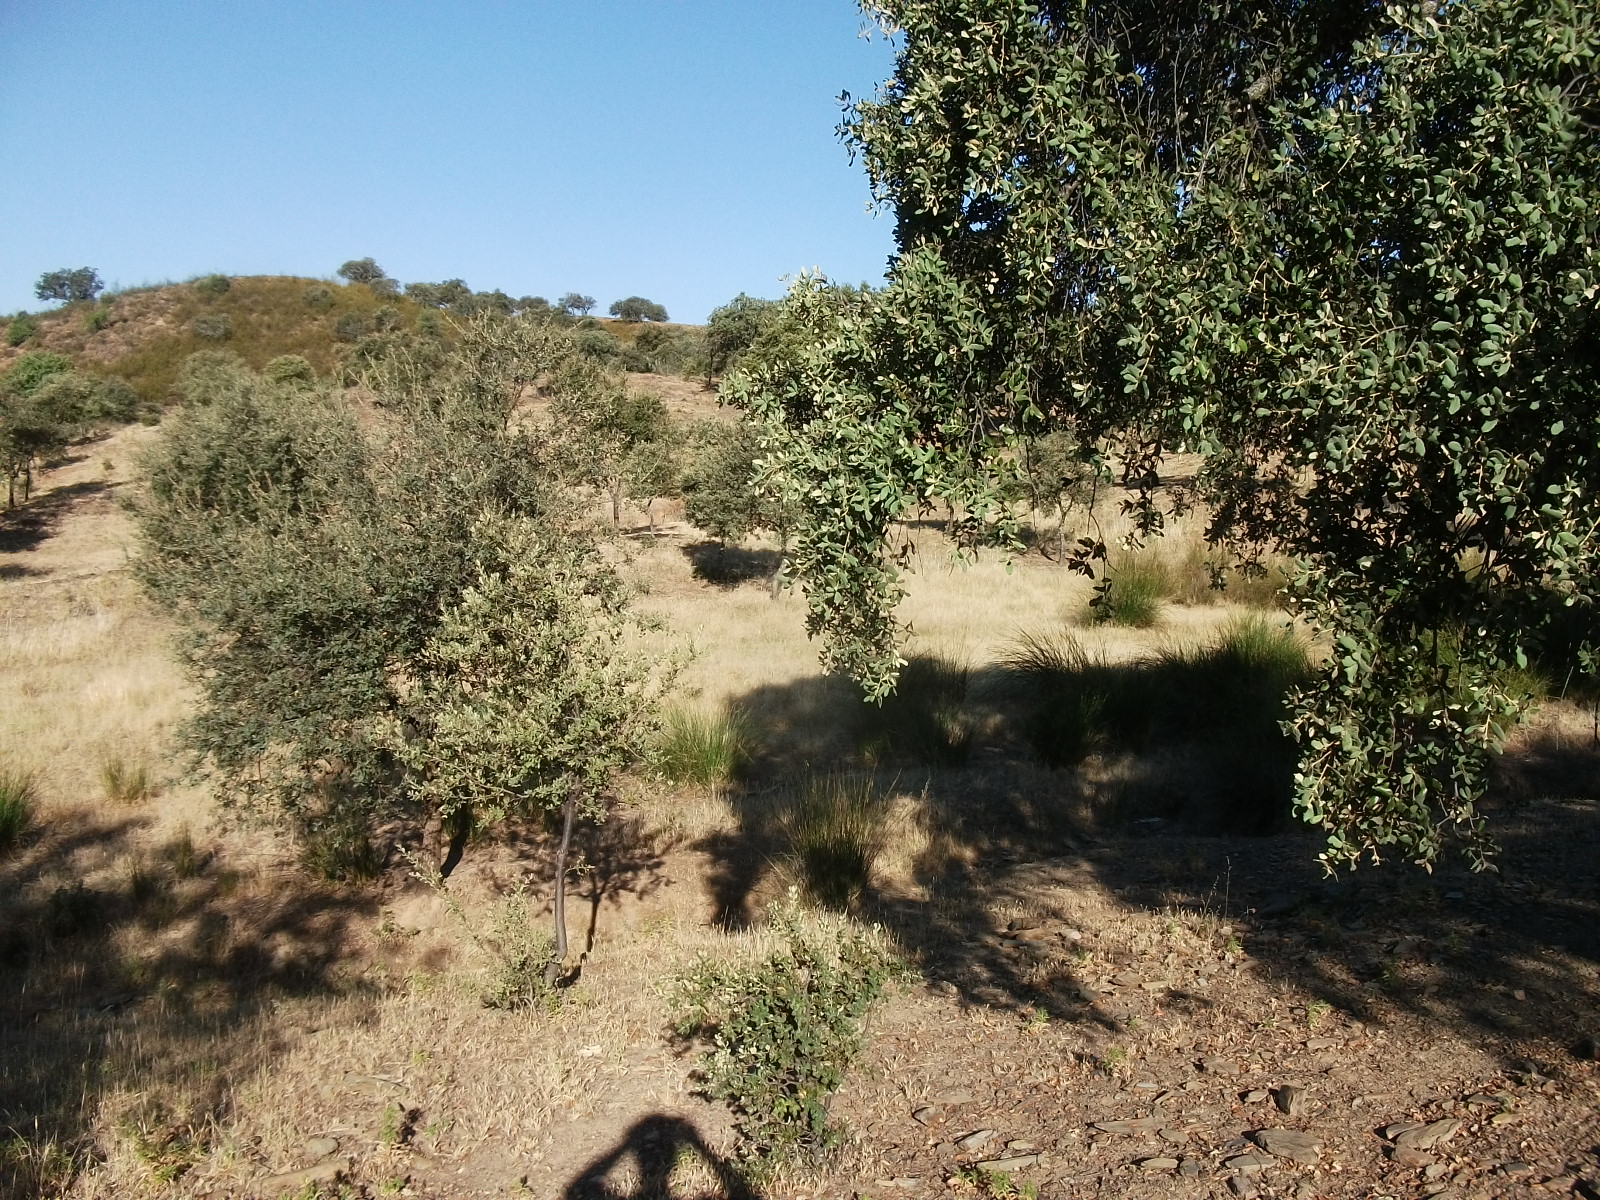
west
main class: Woodland
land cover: Broadleaved woodland
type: broadleaved evergreen forest
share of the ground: 50 - 75 %
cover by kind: broadleaved forest trees 70 %, herbaceous plants 20 %, unconsolidated bare surface 10 %
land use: Agriculture (excluding fallow land and kitchen gardens)
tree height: < 5 m
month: June
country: ES
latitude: 37.6609
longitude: -7.0176
